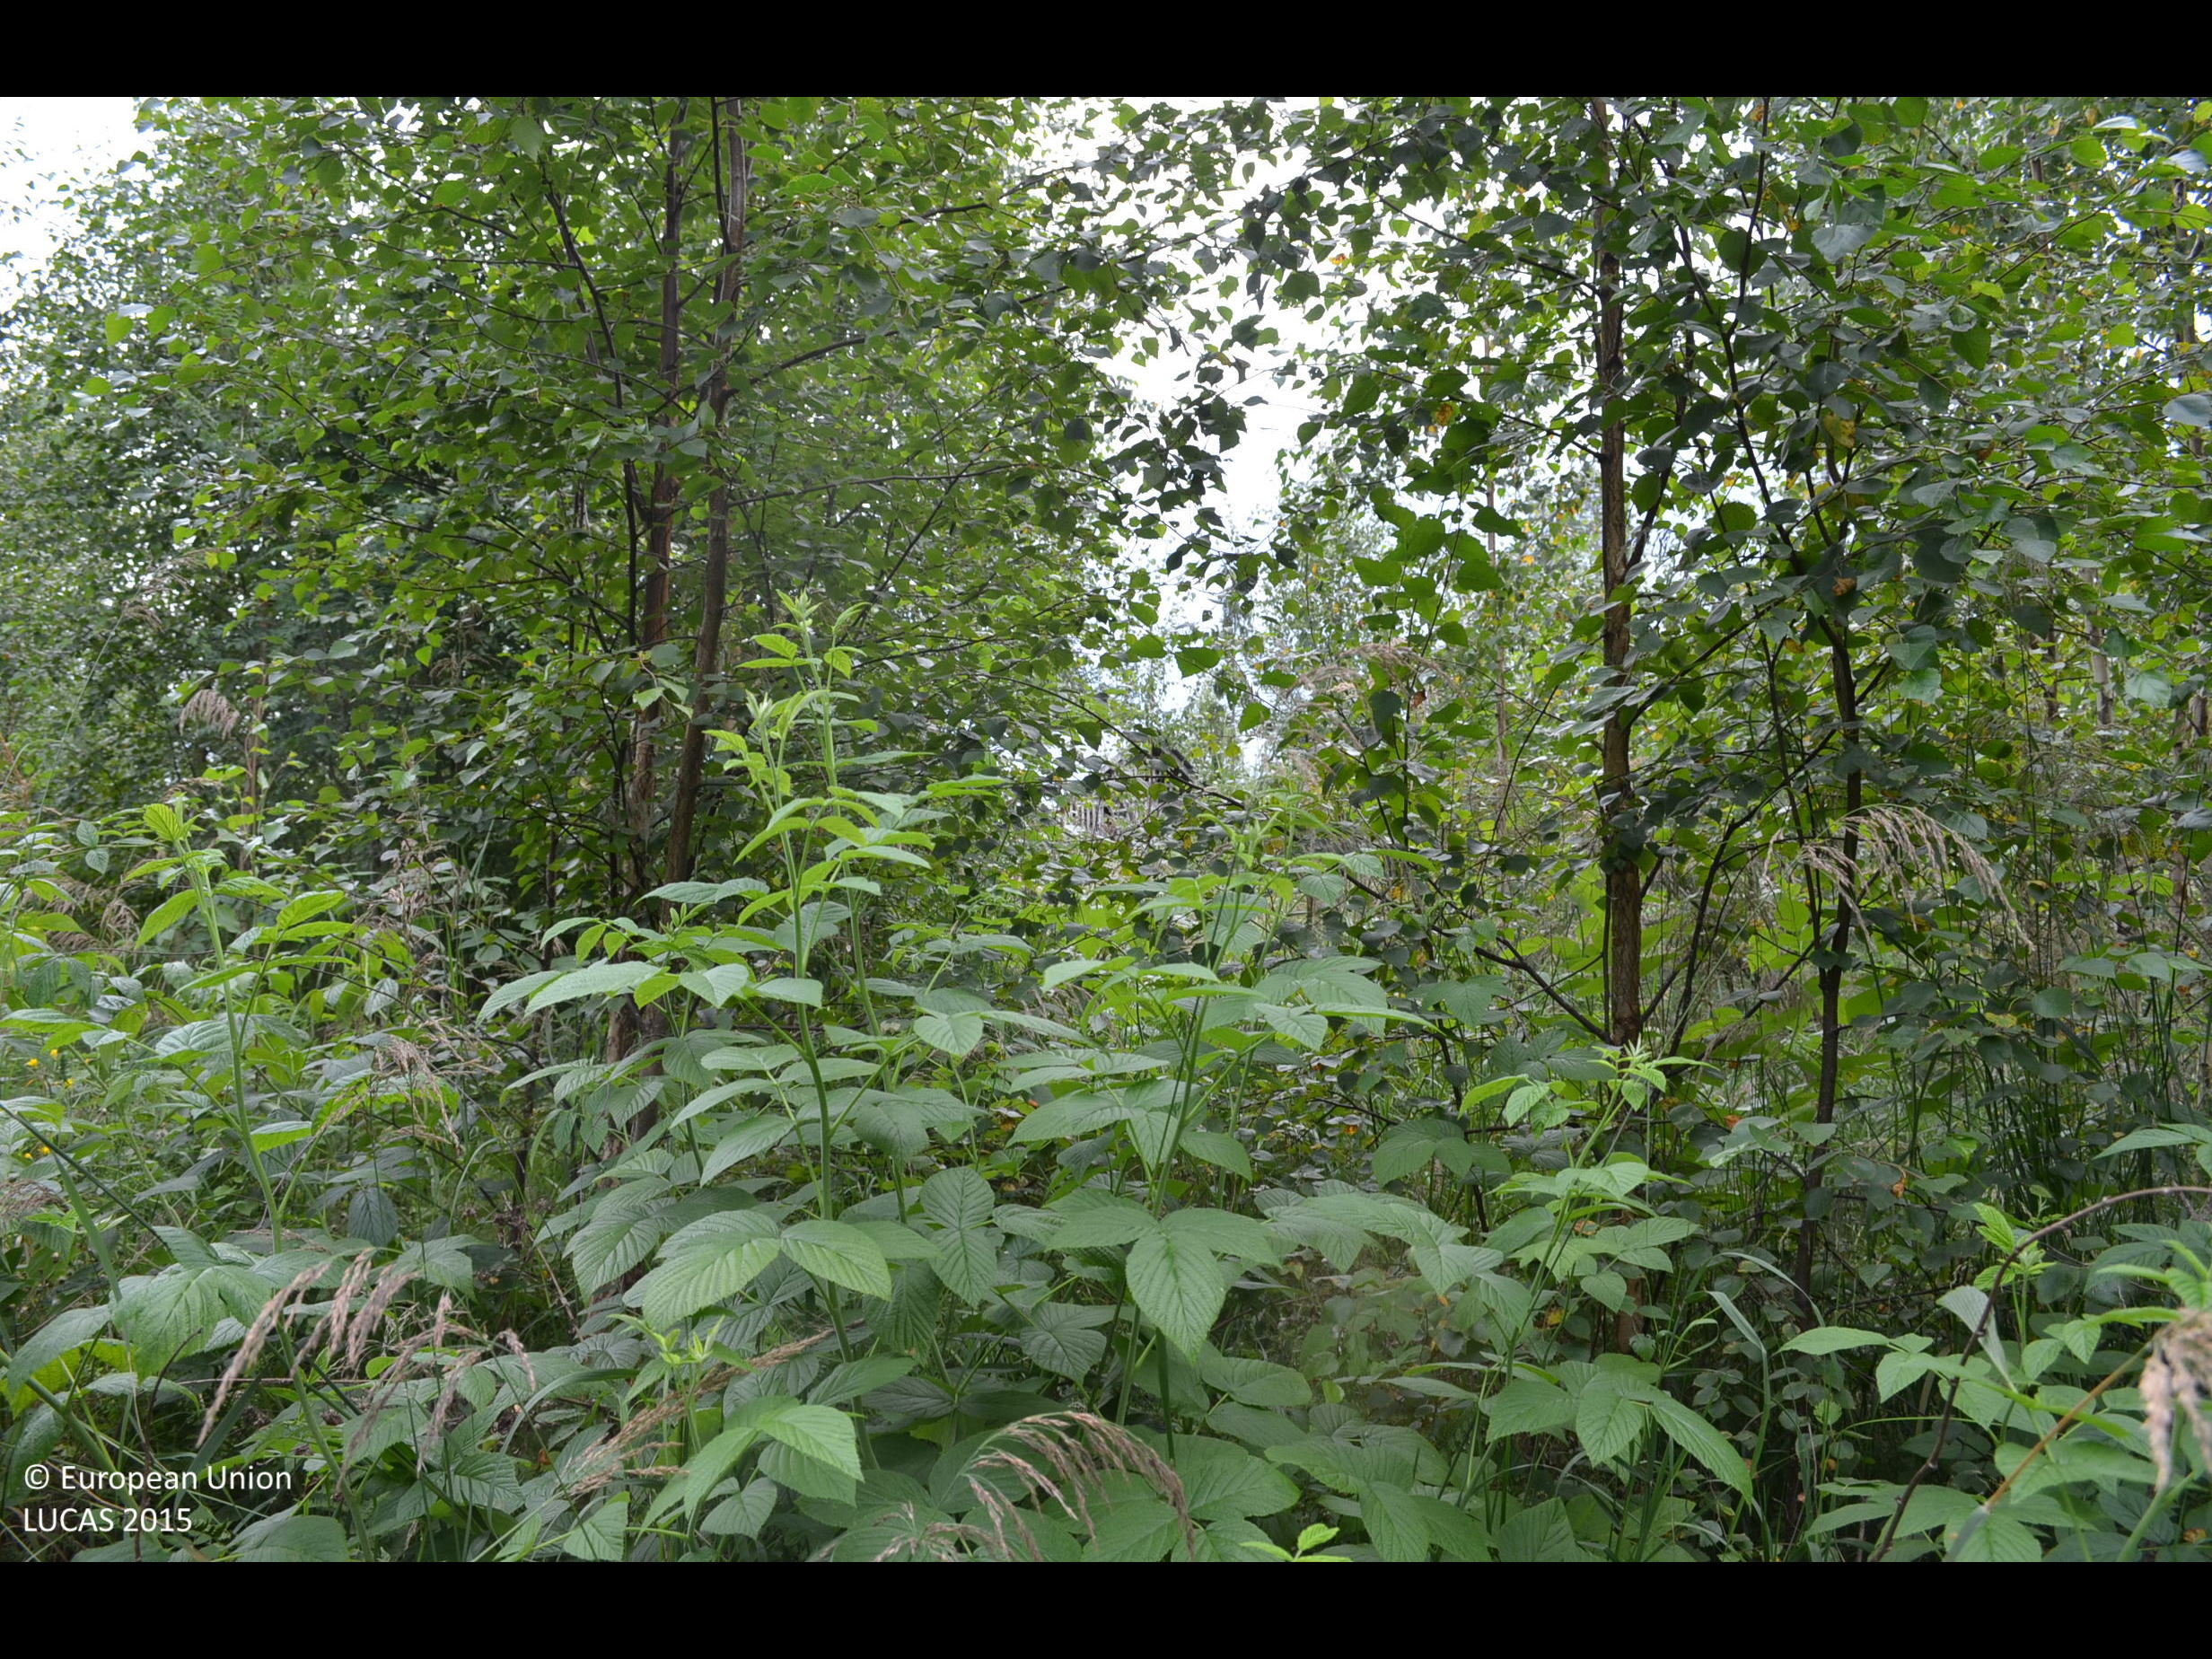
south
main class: Woodland
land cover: Broadleaved woodland
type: boreal forest
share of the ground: 50 - 75 %
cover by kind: broadleaved forest trees 60 %, shrubs 25 %, herbaceous plants 10 %, coniferous forest trees 5 %
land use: Forestry
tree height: < 5 m
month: August
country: FI
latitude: 61.5735
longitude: 23.1607
